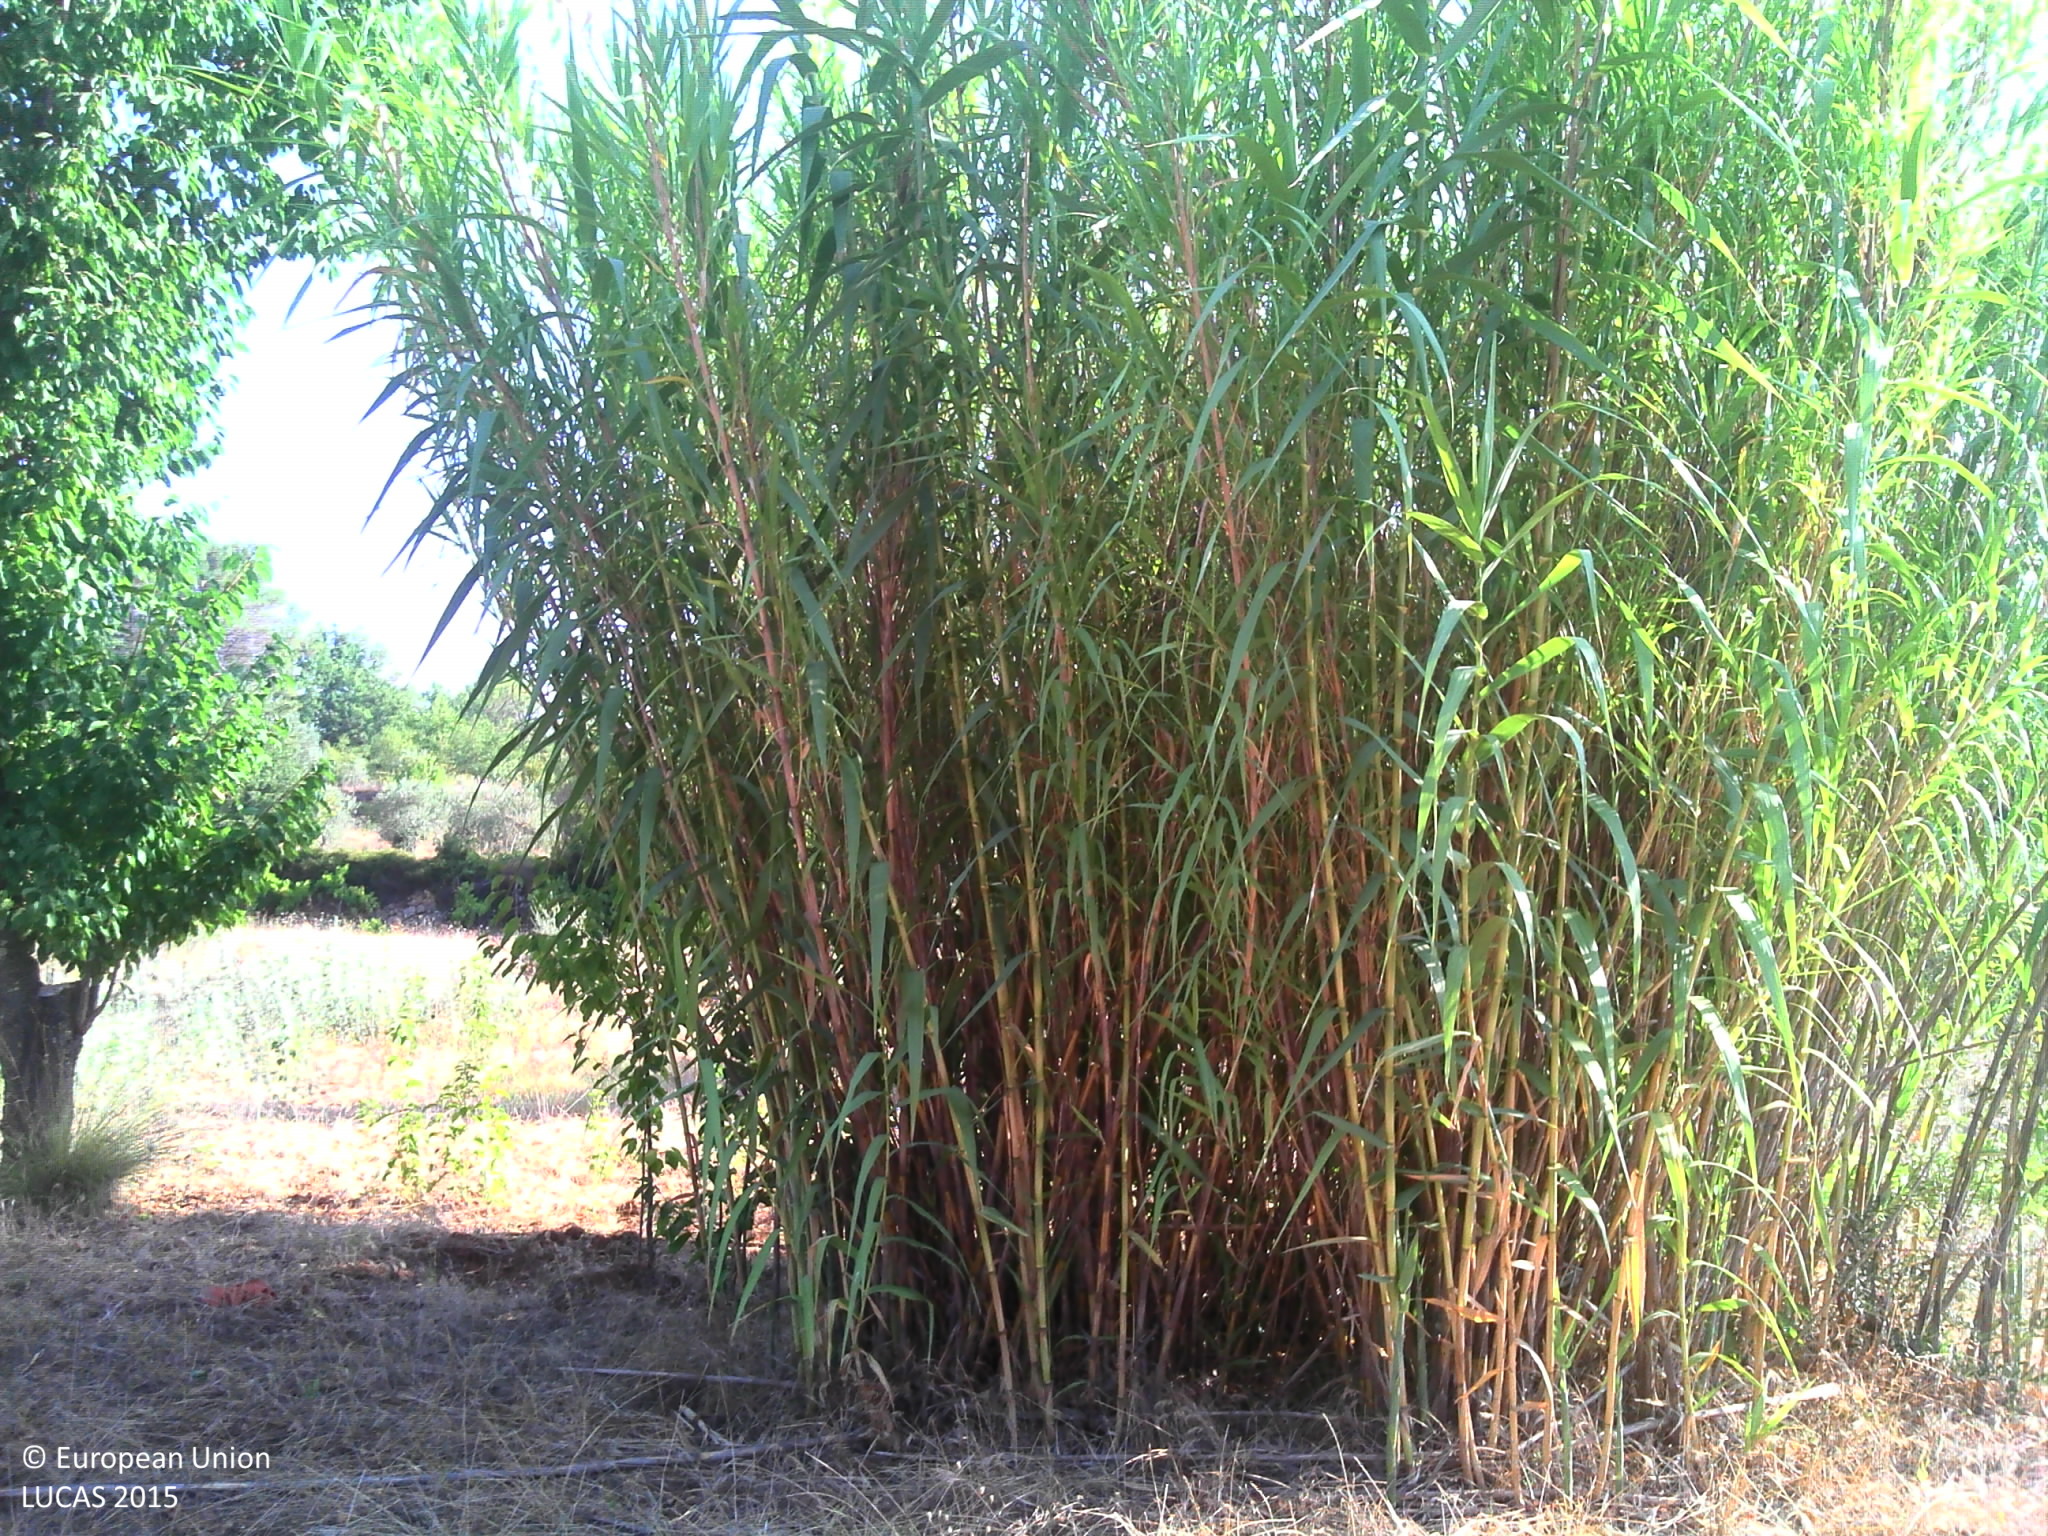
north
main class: Grassland
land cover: Grassland with sparse tree/shrub cover
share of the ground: > 75 %
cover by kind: herbaceous plants 95 %, broadleaved forest trees 5 %
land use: Residential
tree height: > 5 m
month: August
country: FR
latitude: 43.5111
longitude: 6.3843
